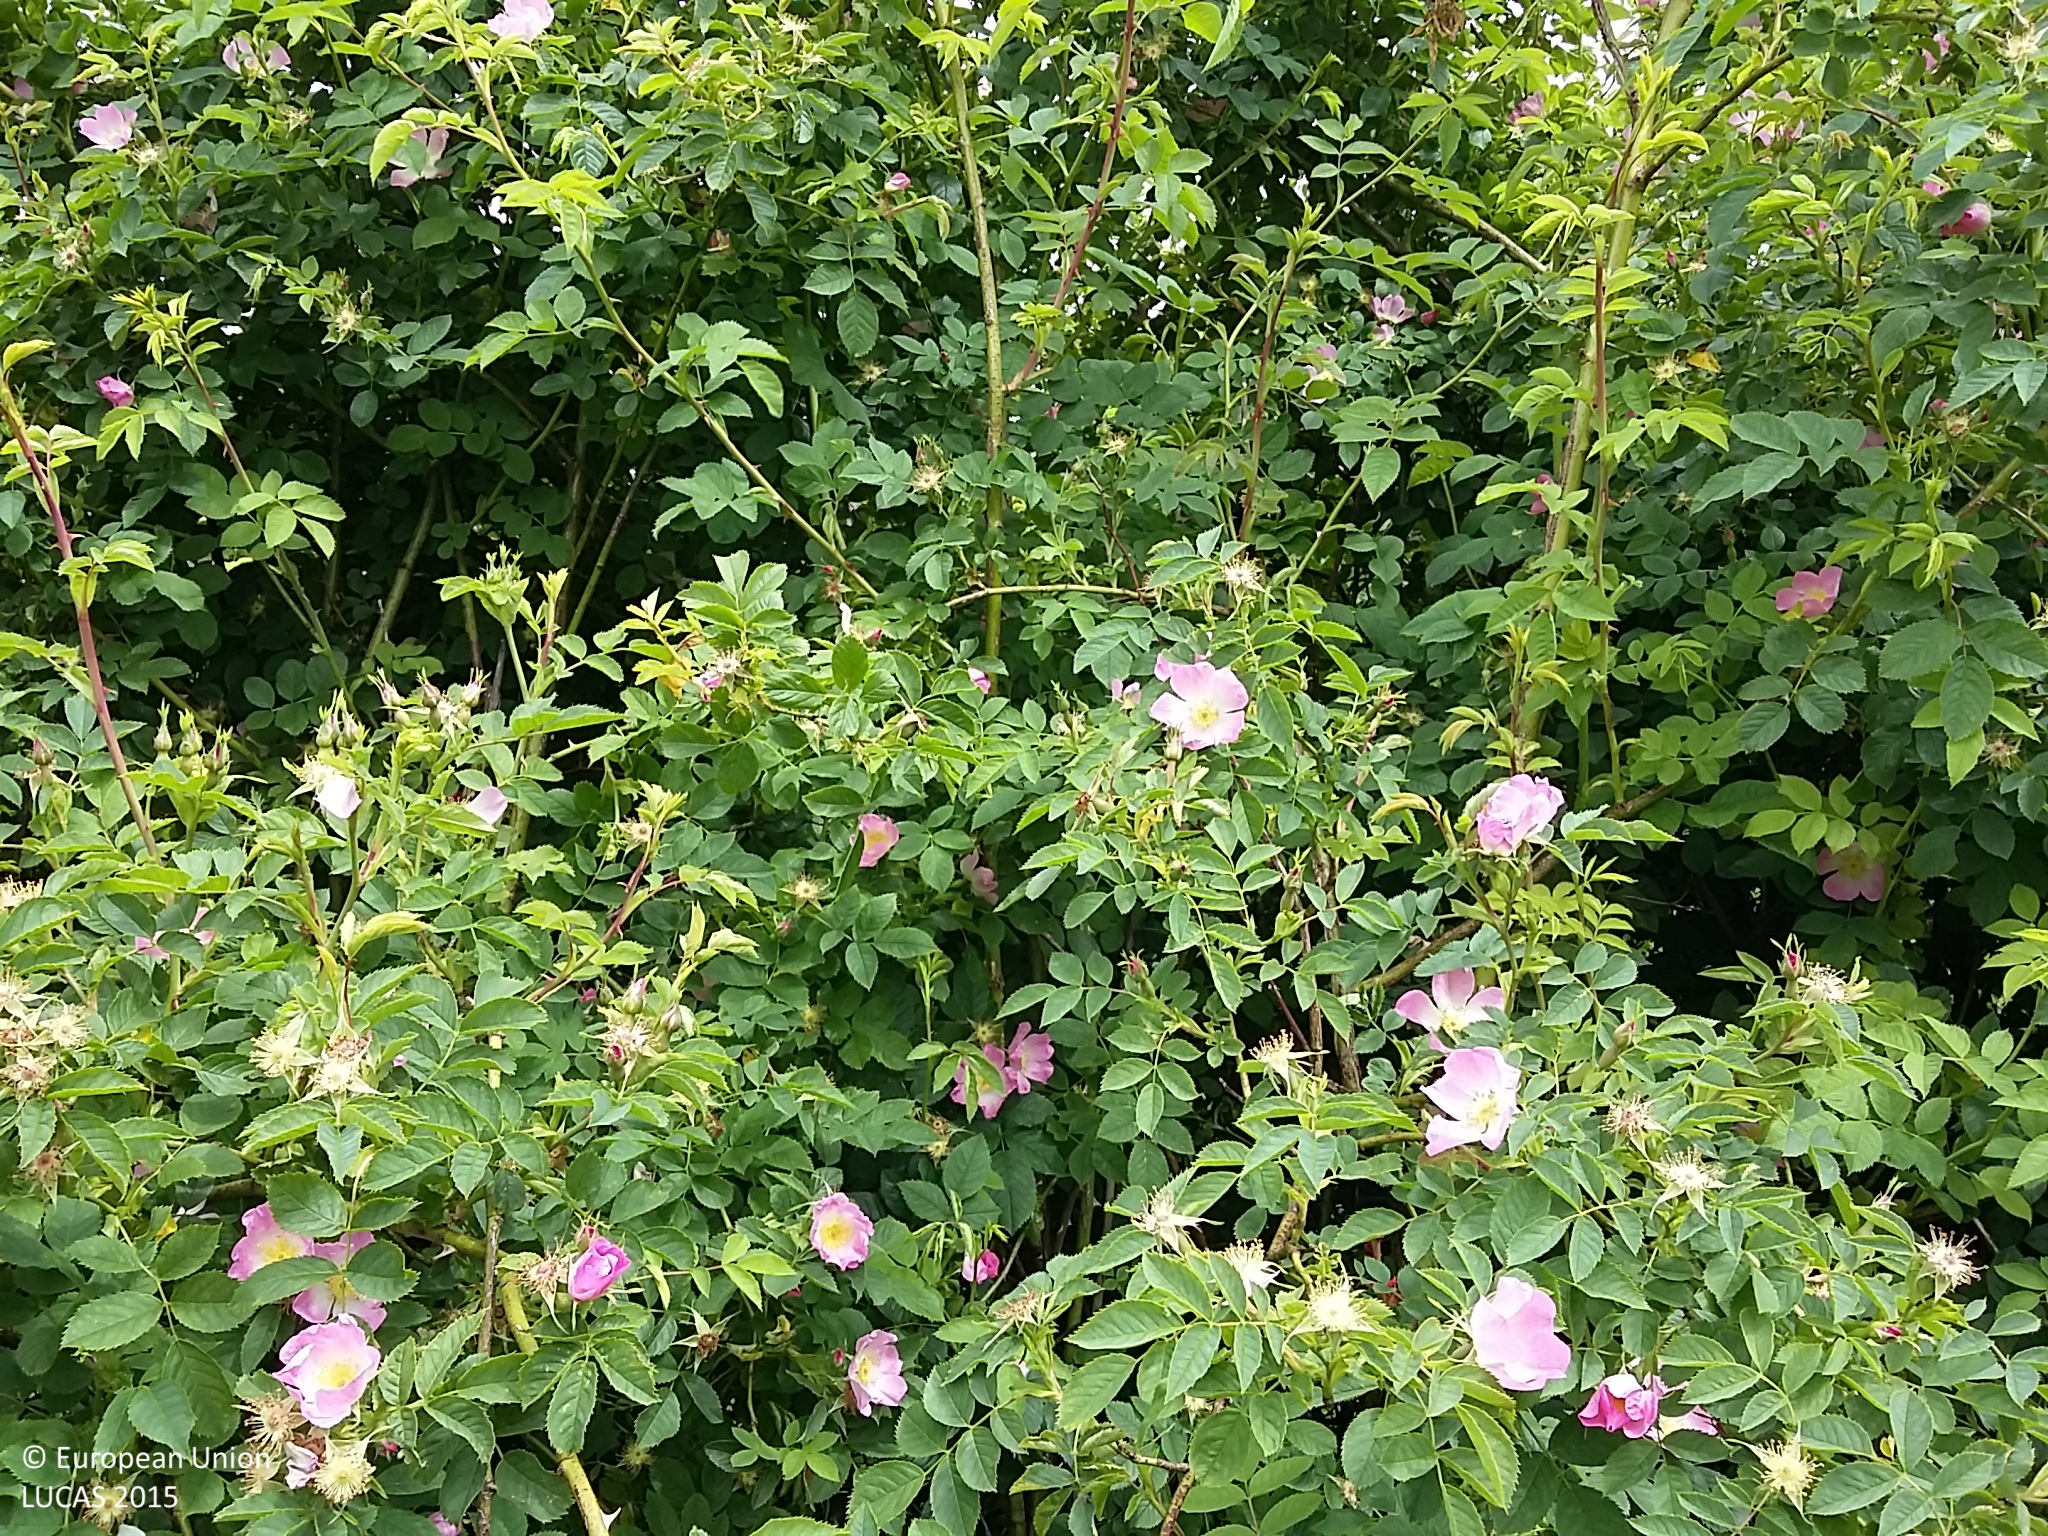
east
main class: Cropland
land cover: Permanent industrial crops
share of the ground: 50 - 75 %
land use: Agriculture (excluding fallow land and kitchen gardens)
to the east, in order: Permanent industrial crops; Grass margins; Paved roads, cycling and walking lanes; Grass margins; Rye
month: June
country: DK
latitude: 54.7572
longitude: 11.6305
